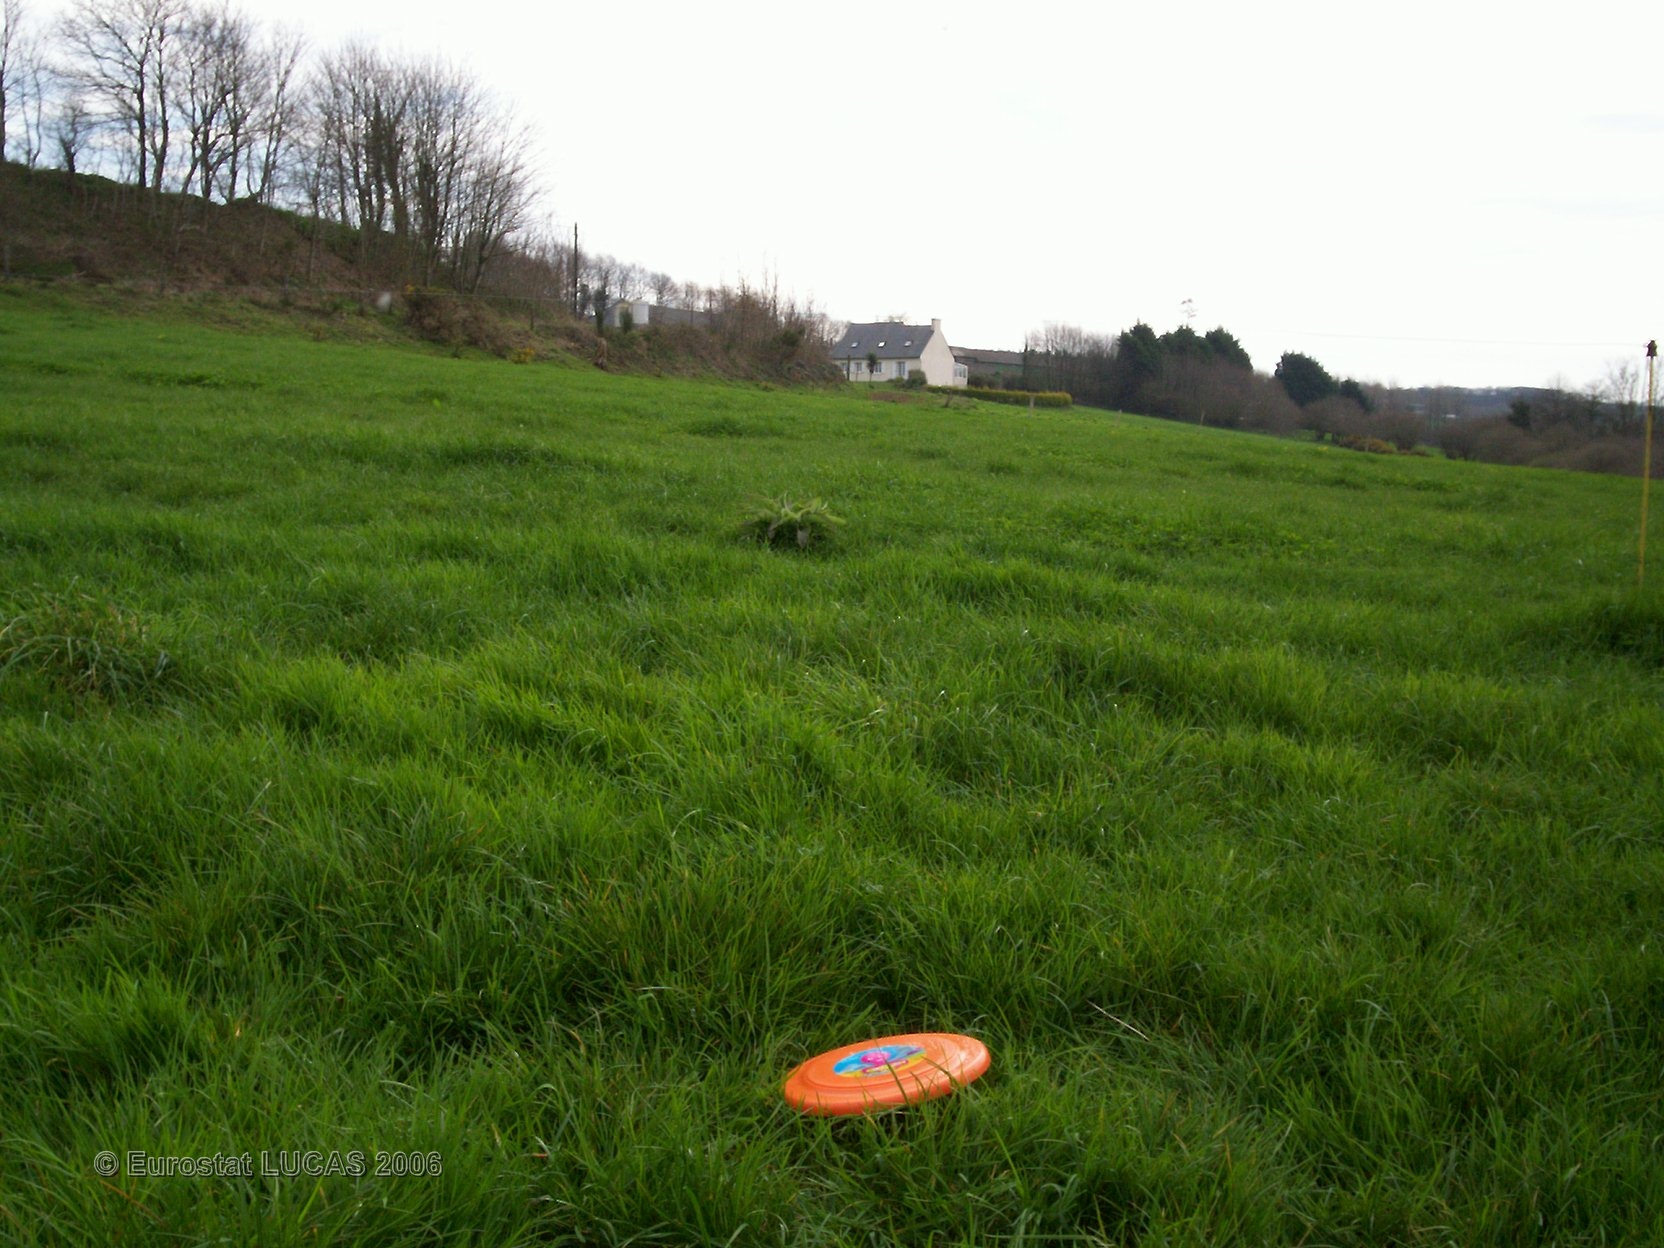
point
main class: Grassland
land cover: Grassland without tree/shrub cover
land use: Agriculture (excluding fallow land and kitchen gardens)
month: April
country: FR
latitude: 48.4842
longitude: -3.9278
